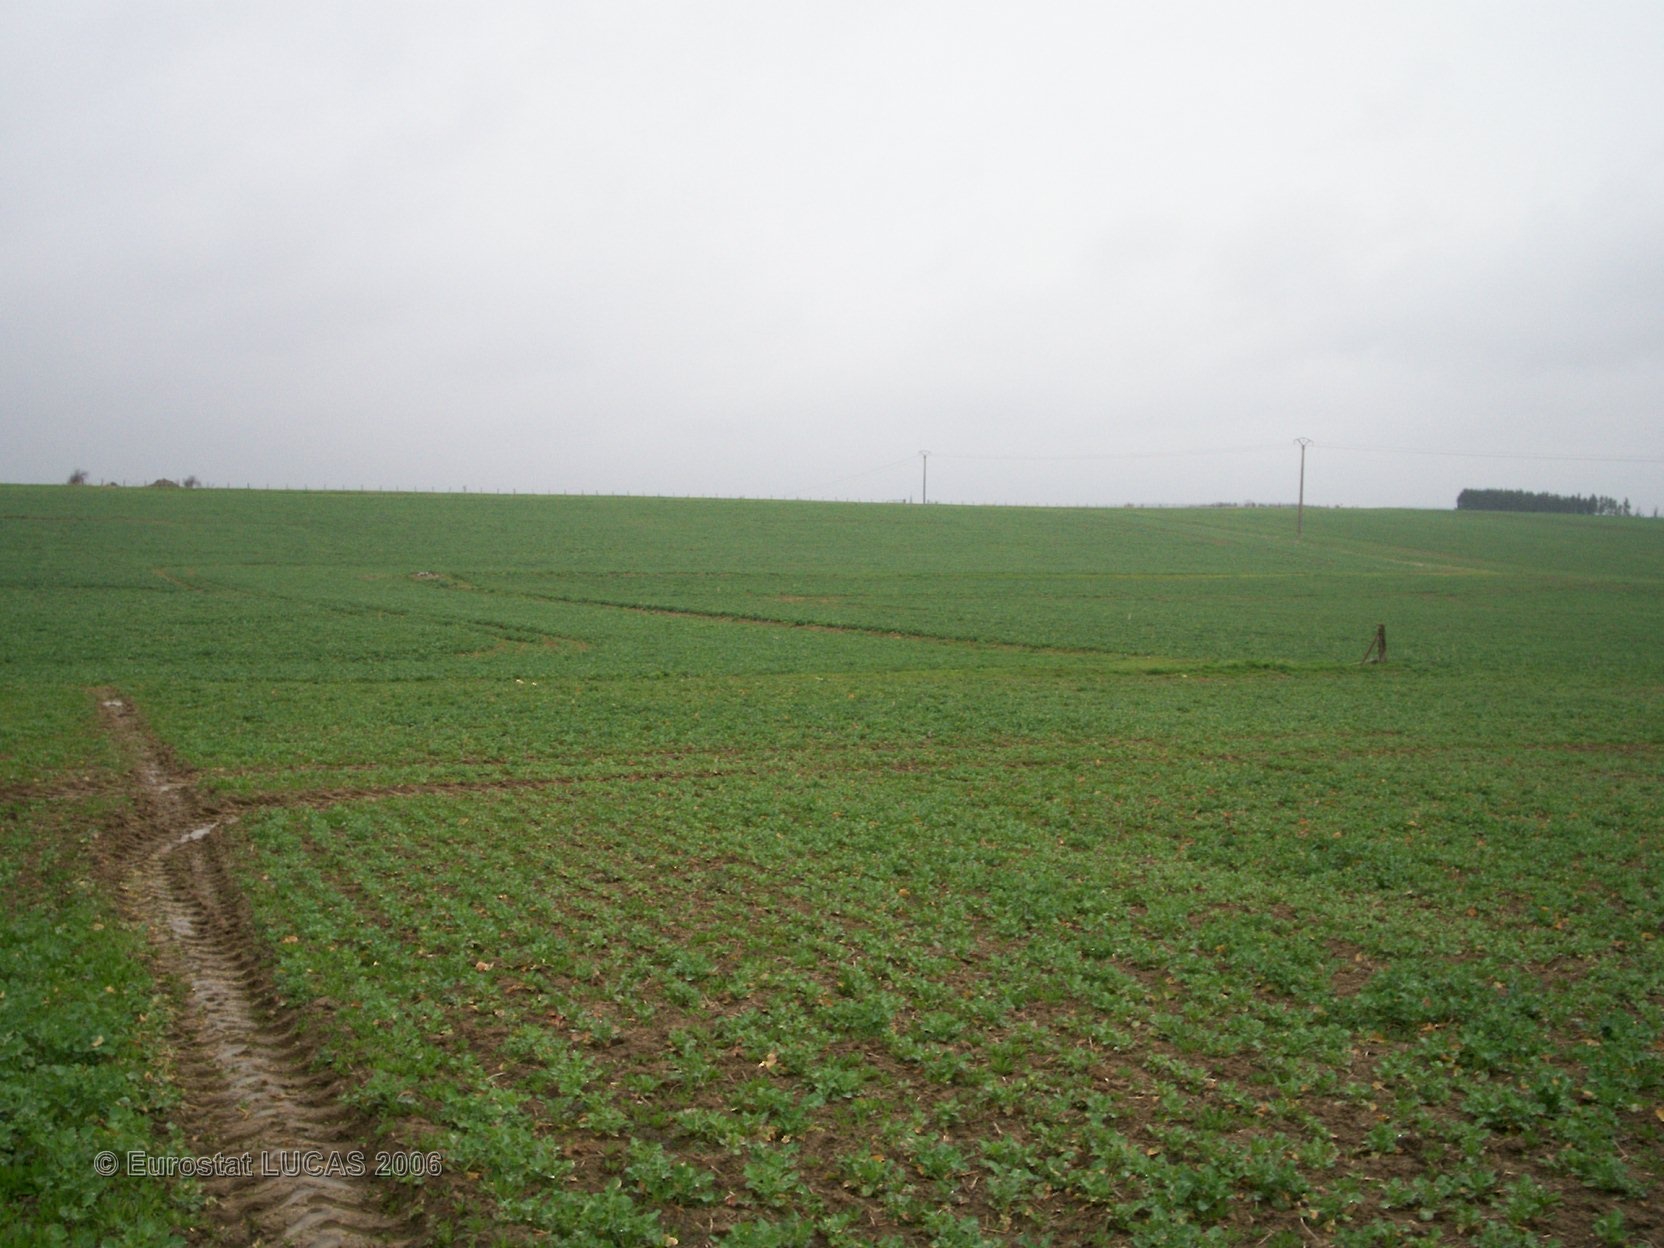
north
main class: Cropland
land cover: Rape and turnip rape
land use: Agriculture (excluding fallow land and kitchen gardens)
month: April
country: FR
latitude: 48.6628
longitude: 6.7827
